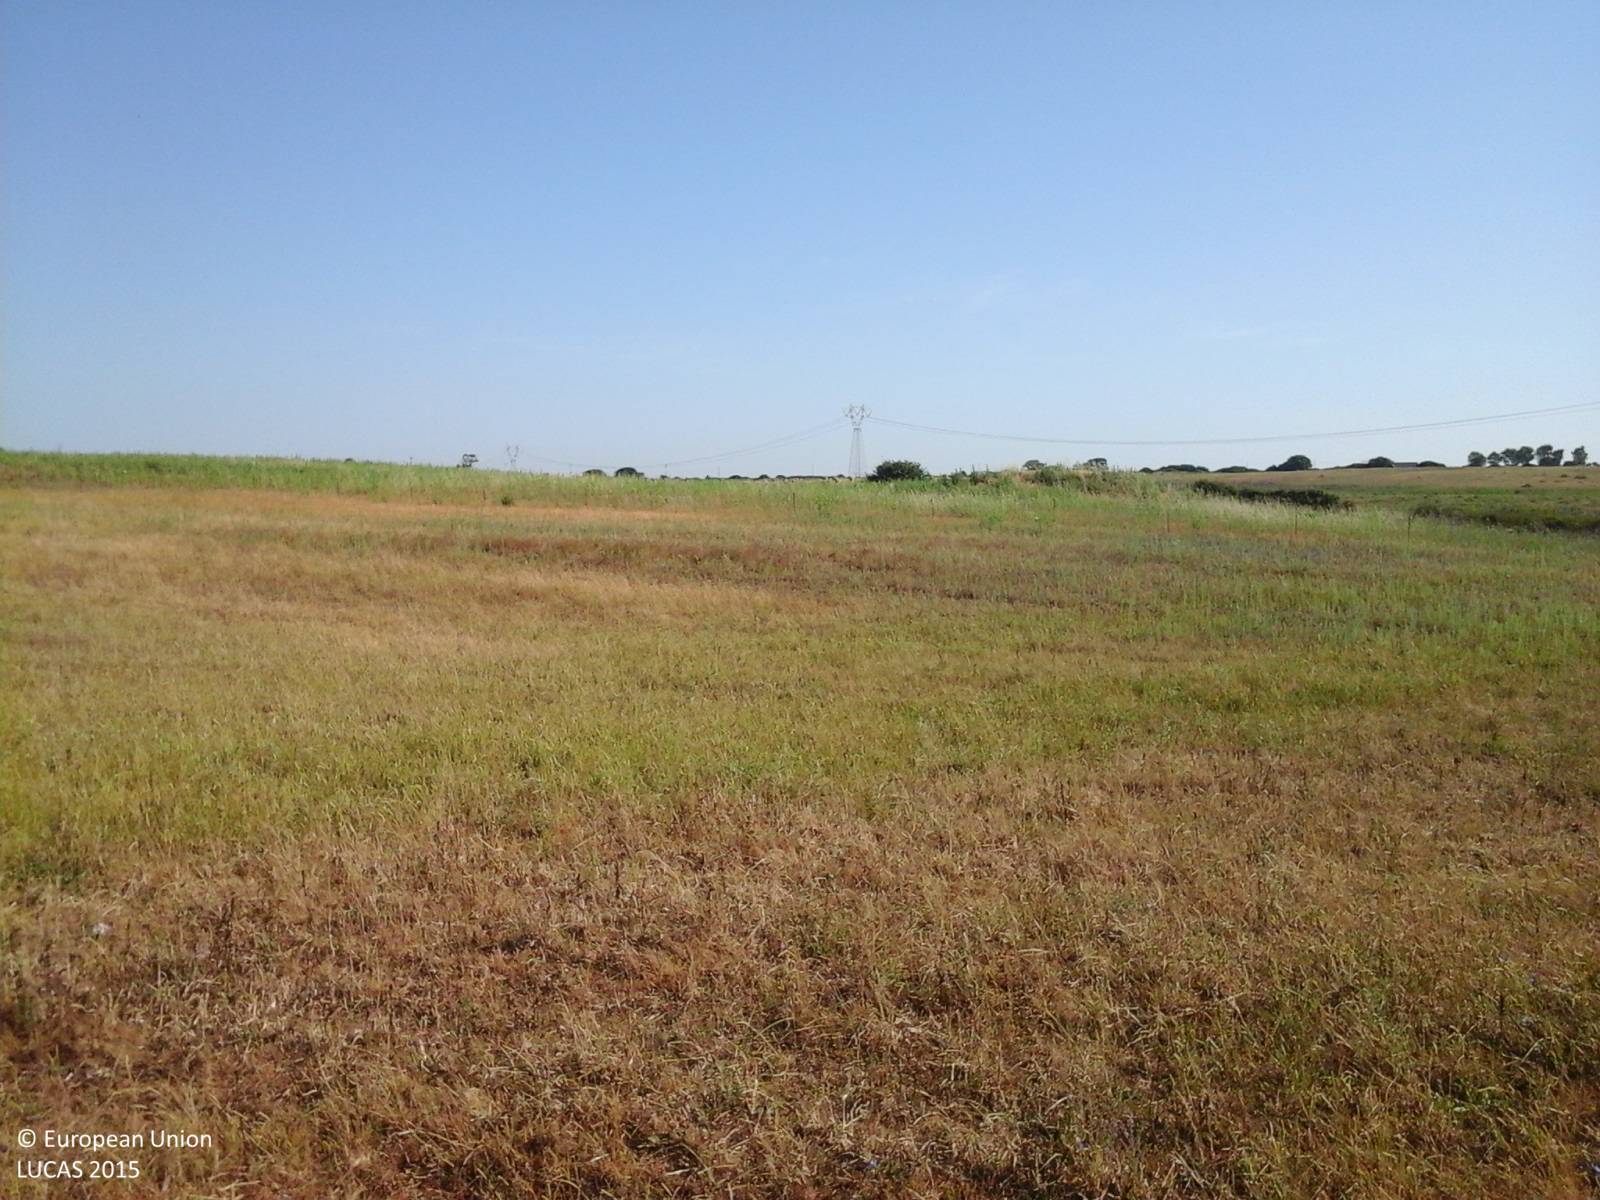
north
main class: Grassland
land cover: Grassland without tree/shrub cover
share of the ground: > 75 %
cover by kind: herbaceous plants 100 %
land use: Agriculture (excluding fallow land and kitchen gardens)
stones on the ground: < 10 %
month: June
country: IT
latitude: 40.7070
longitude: 8.4098
